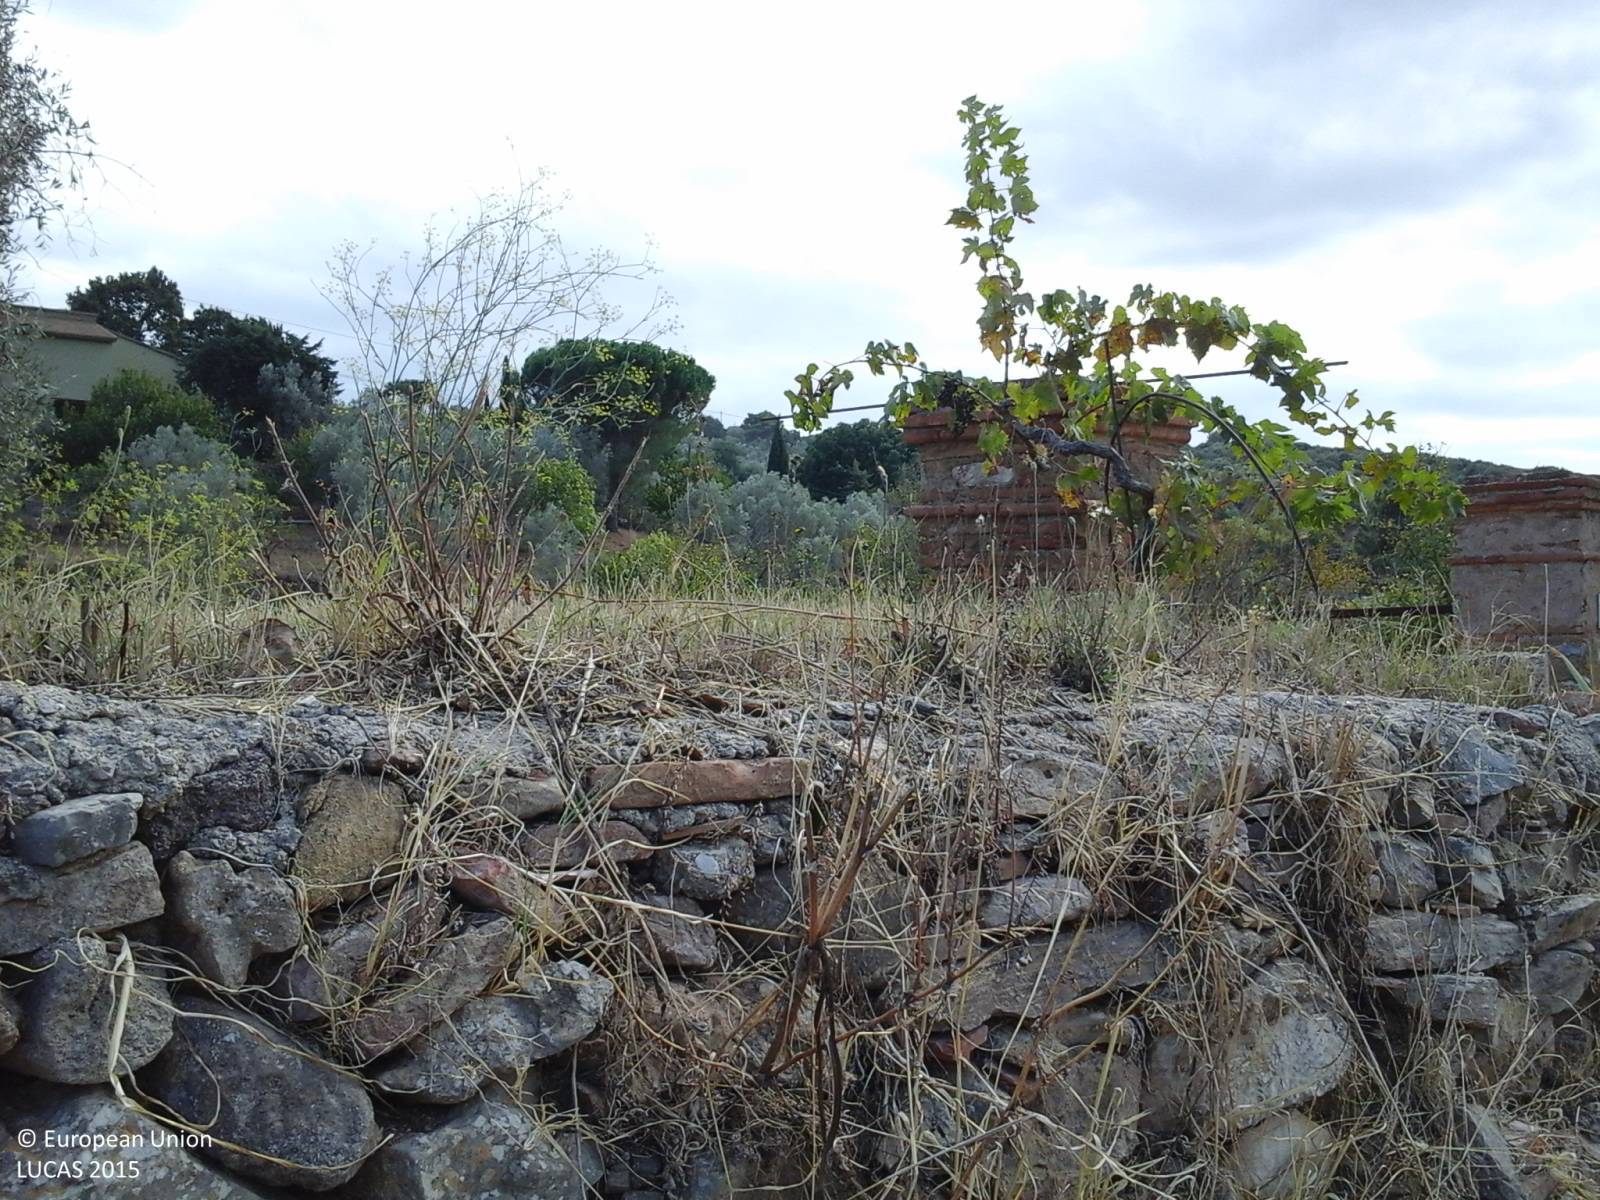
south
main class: Grassland
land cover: Grassland without tree/shrub cover
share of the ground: 50 - 75 %
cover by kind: herbaceous plants 100 %
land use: Agriculture (excluding fallow land and kitchen gardens)
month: September
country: IT
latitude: 43.0495
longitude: 10.5997
